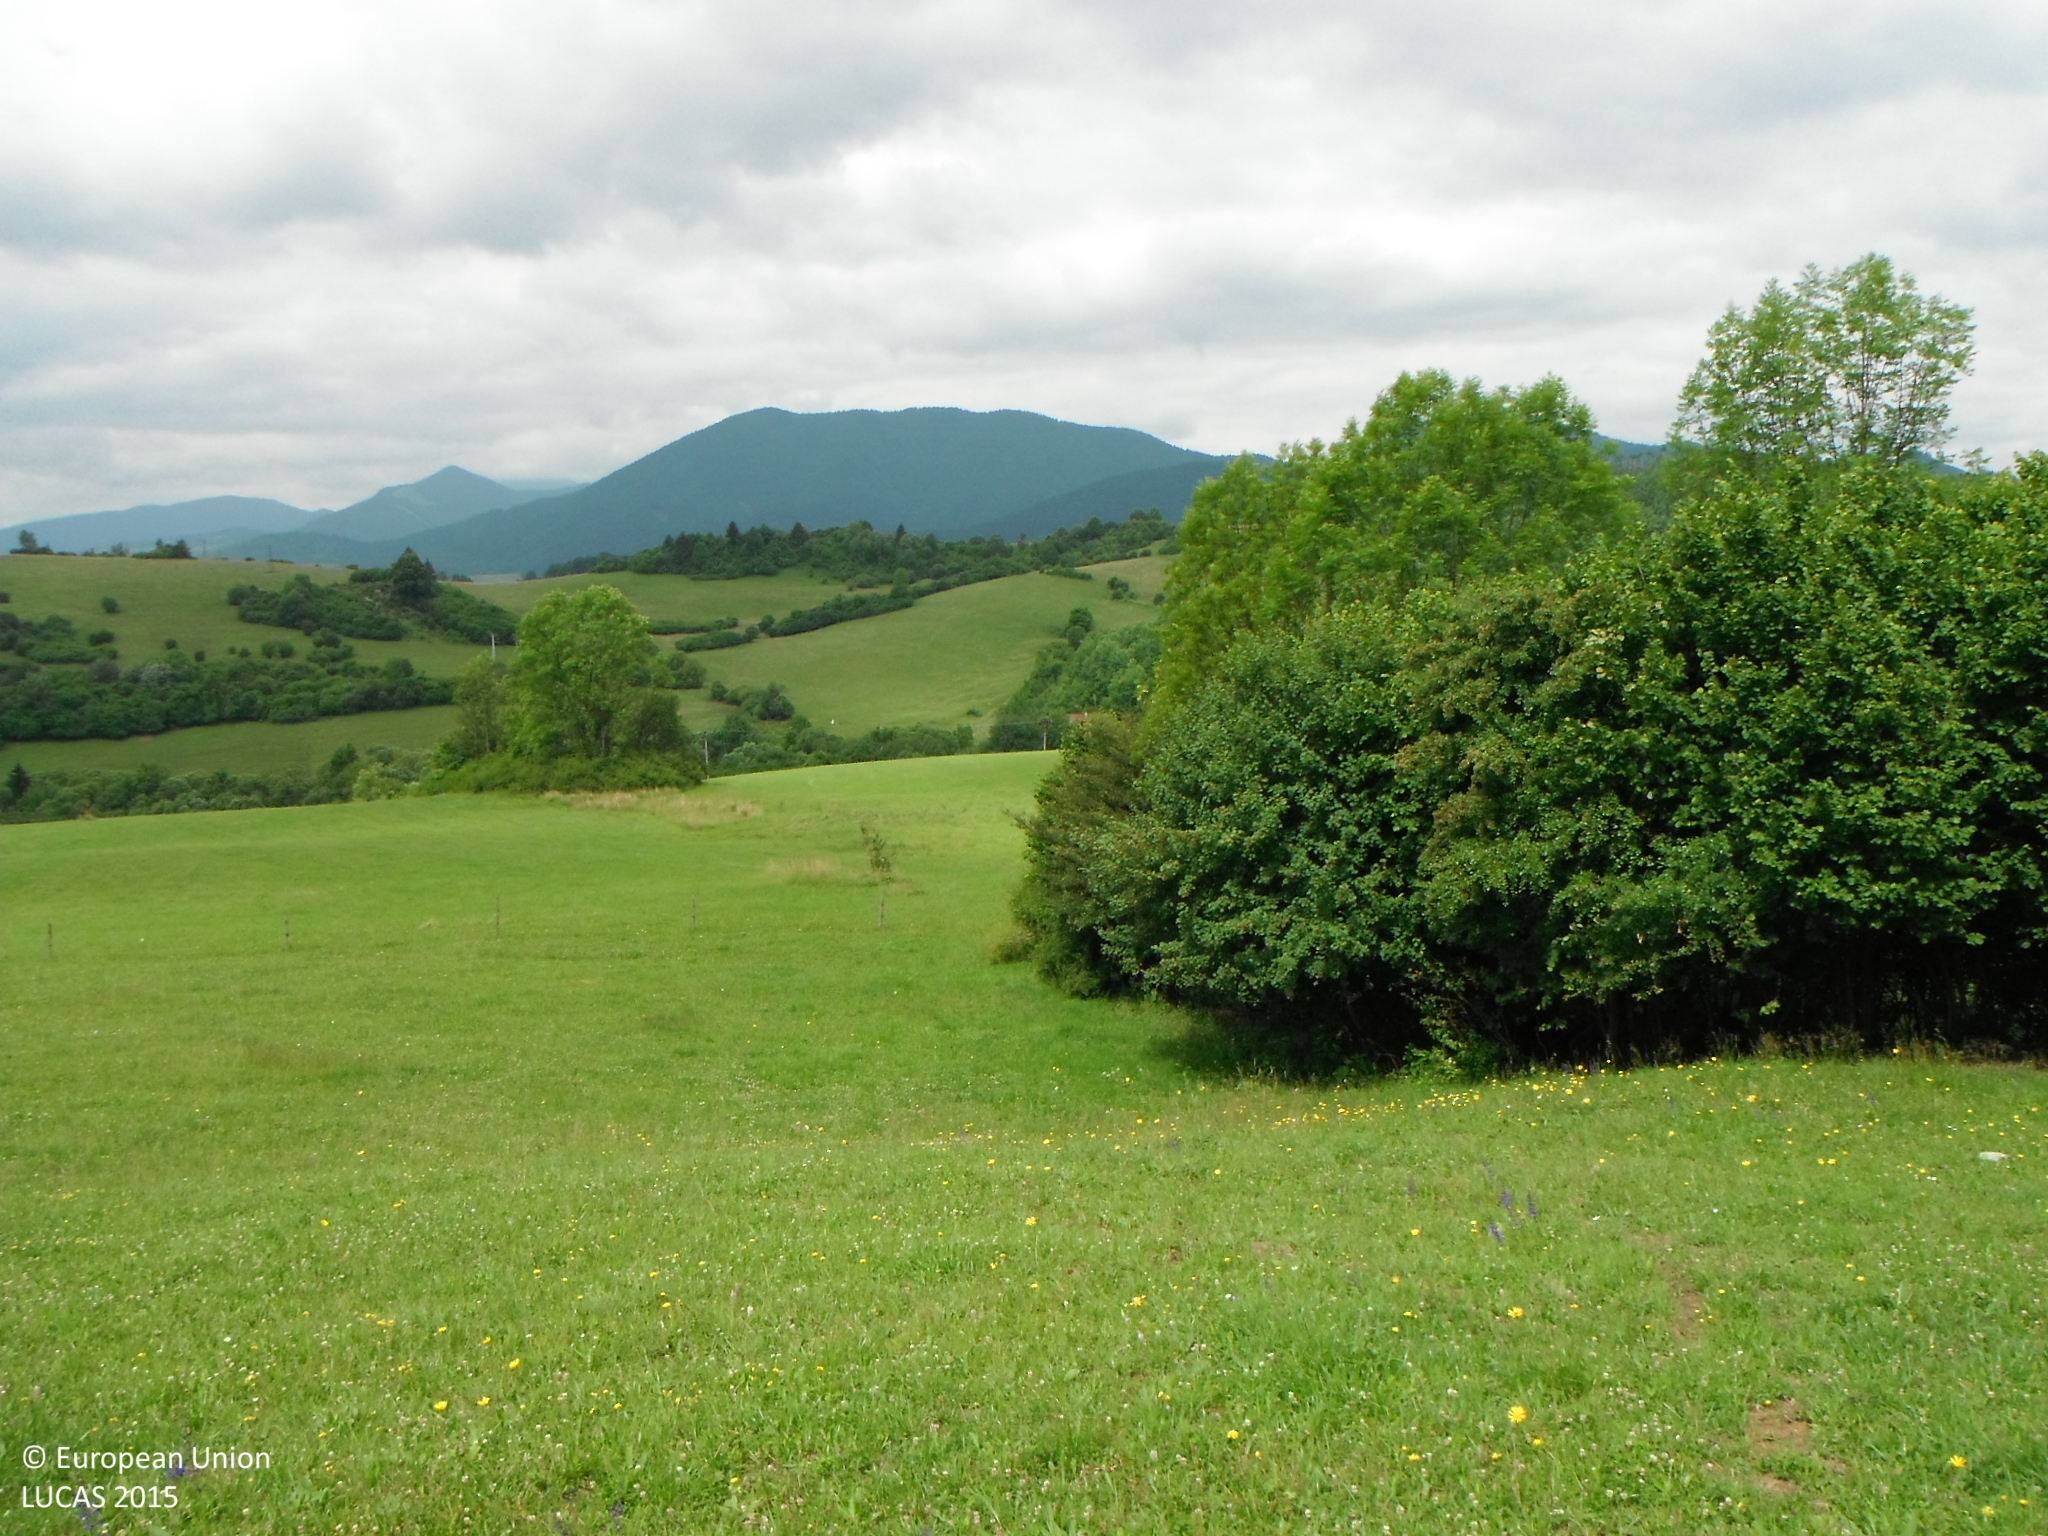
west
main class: Grassland
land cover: Grassland without tree/shrub cover
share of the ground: > 75 %
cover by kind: herbaceous plants 100 %
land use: Agriculture (excluding fallow land and kitchen gardens)
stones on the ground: < 10 %
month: June
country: SK
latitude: 49.2269
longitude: 19.2655
